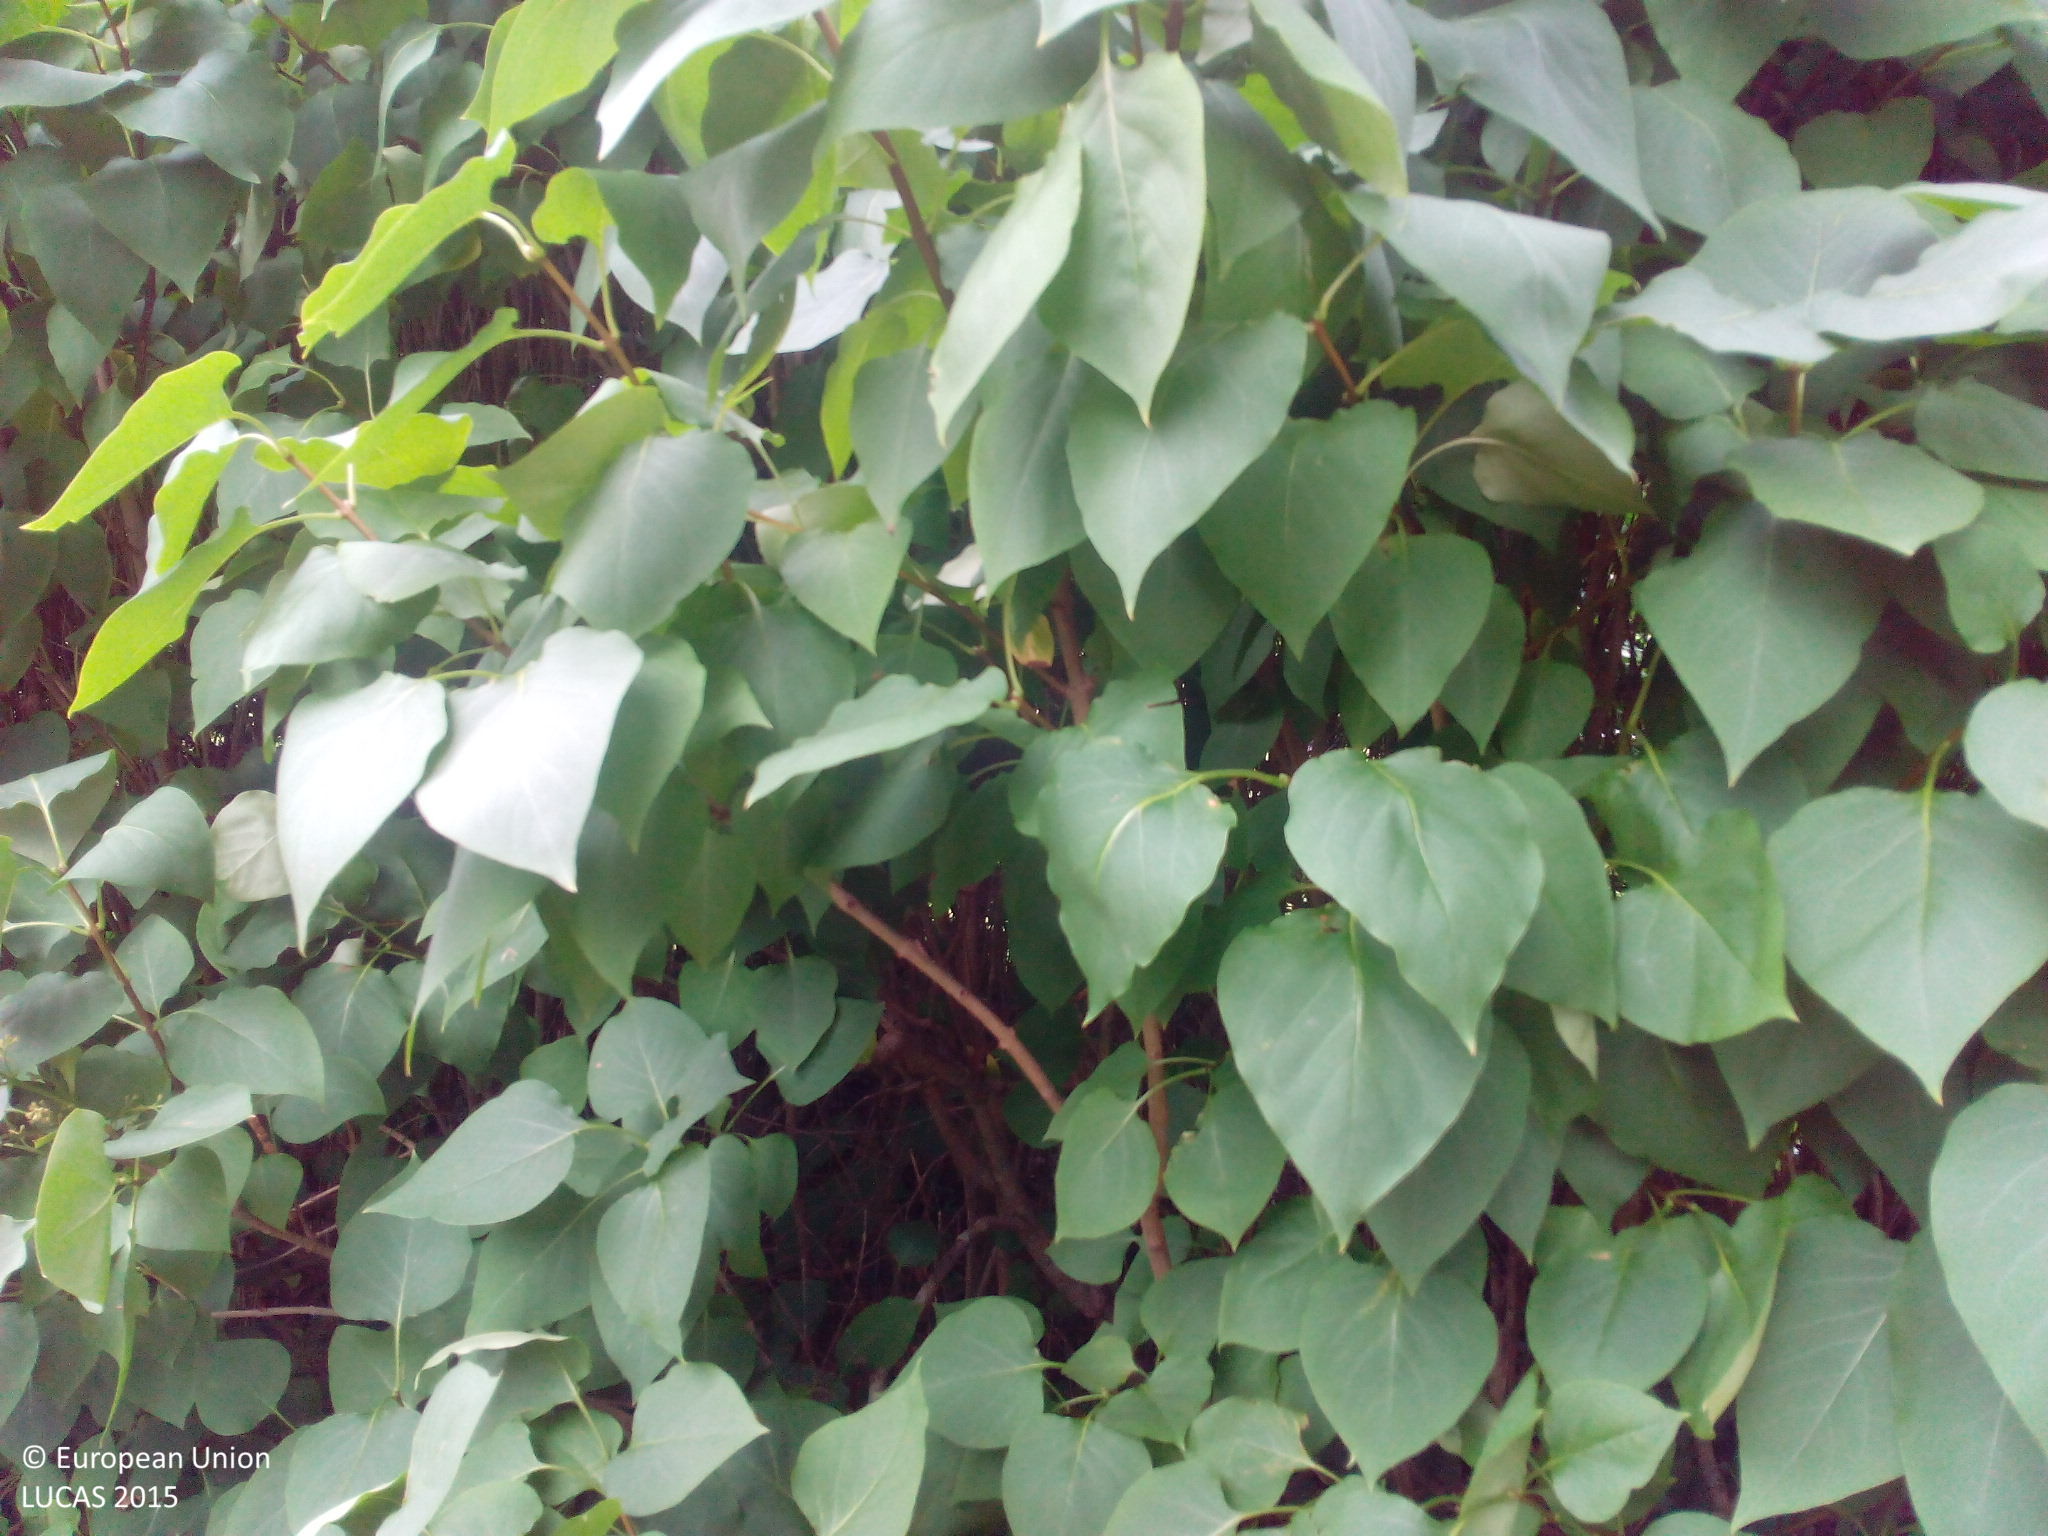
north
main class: Woodland
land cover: Broadleaved woodland
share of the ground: 10 - 25 %
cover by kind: herbaceous plants 85 %, broadleaved forest trees 15 %
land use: Residential
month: August
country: DK
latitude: 55.5442
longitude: 11.9160
